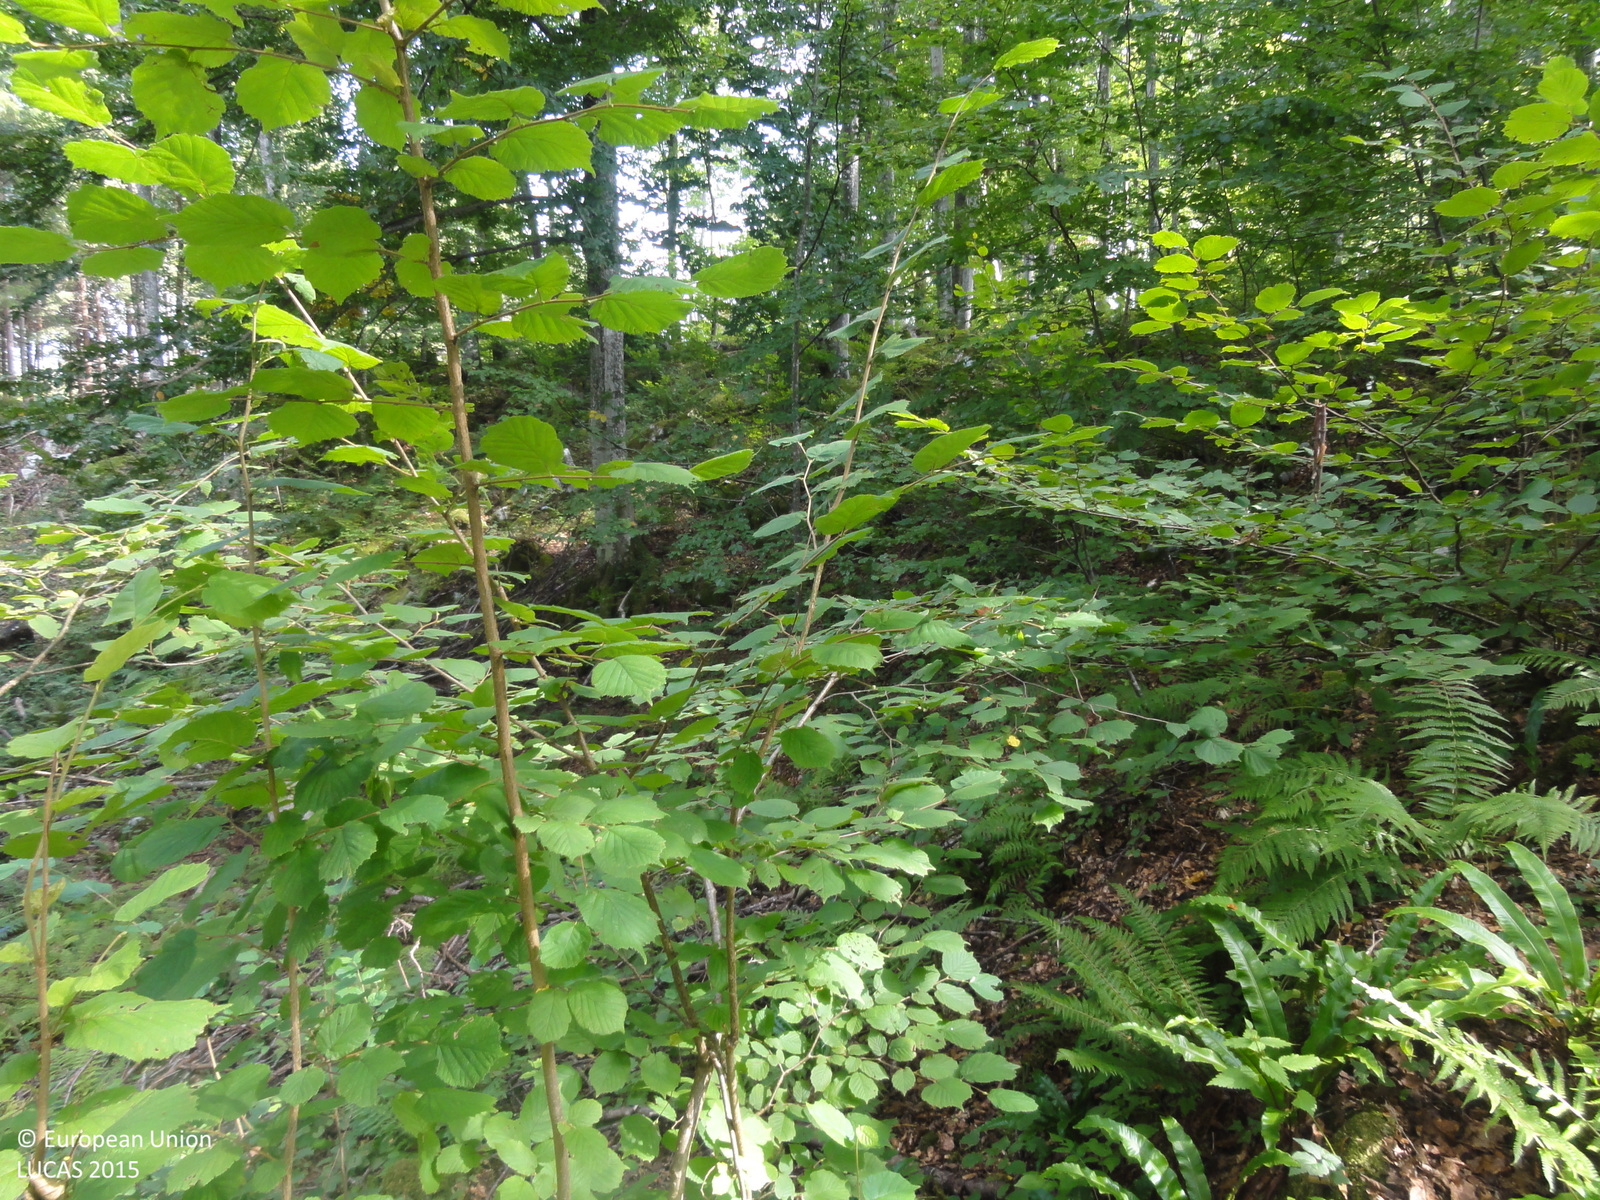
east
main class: Woodland
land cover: Broadleaved woodland
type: beech forest
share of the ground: > 75 %
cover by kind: broadleaved forest trees 90 %, coniferous forest trees 10 %
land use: Forestry
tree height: > 5 m
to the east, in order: Broadleaved woodland; Tracks; Spruce dominated coniferous woodland; Spruce dominated mixed woodland; Tracks; Spruce dominated mixed woodland; Tracks; Spruce dominated coniferous woodland; Spruce dominated mixed woodland
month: September
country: SI
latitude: 45.5806
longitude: 15.0838
